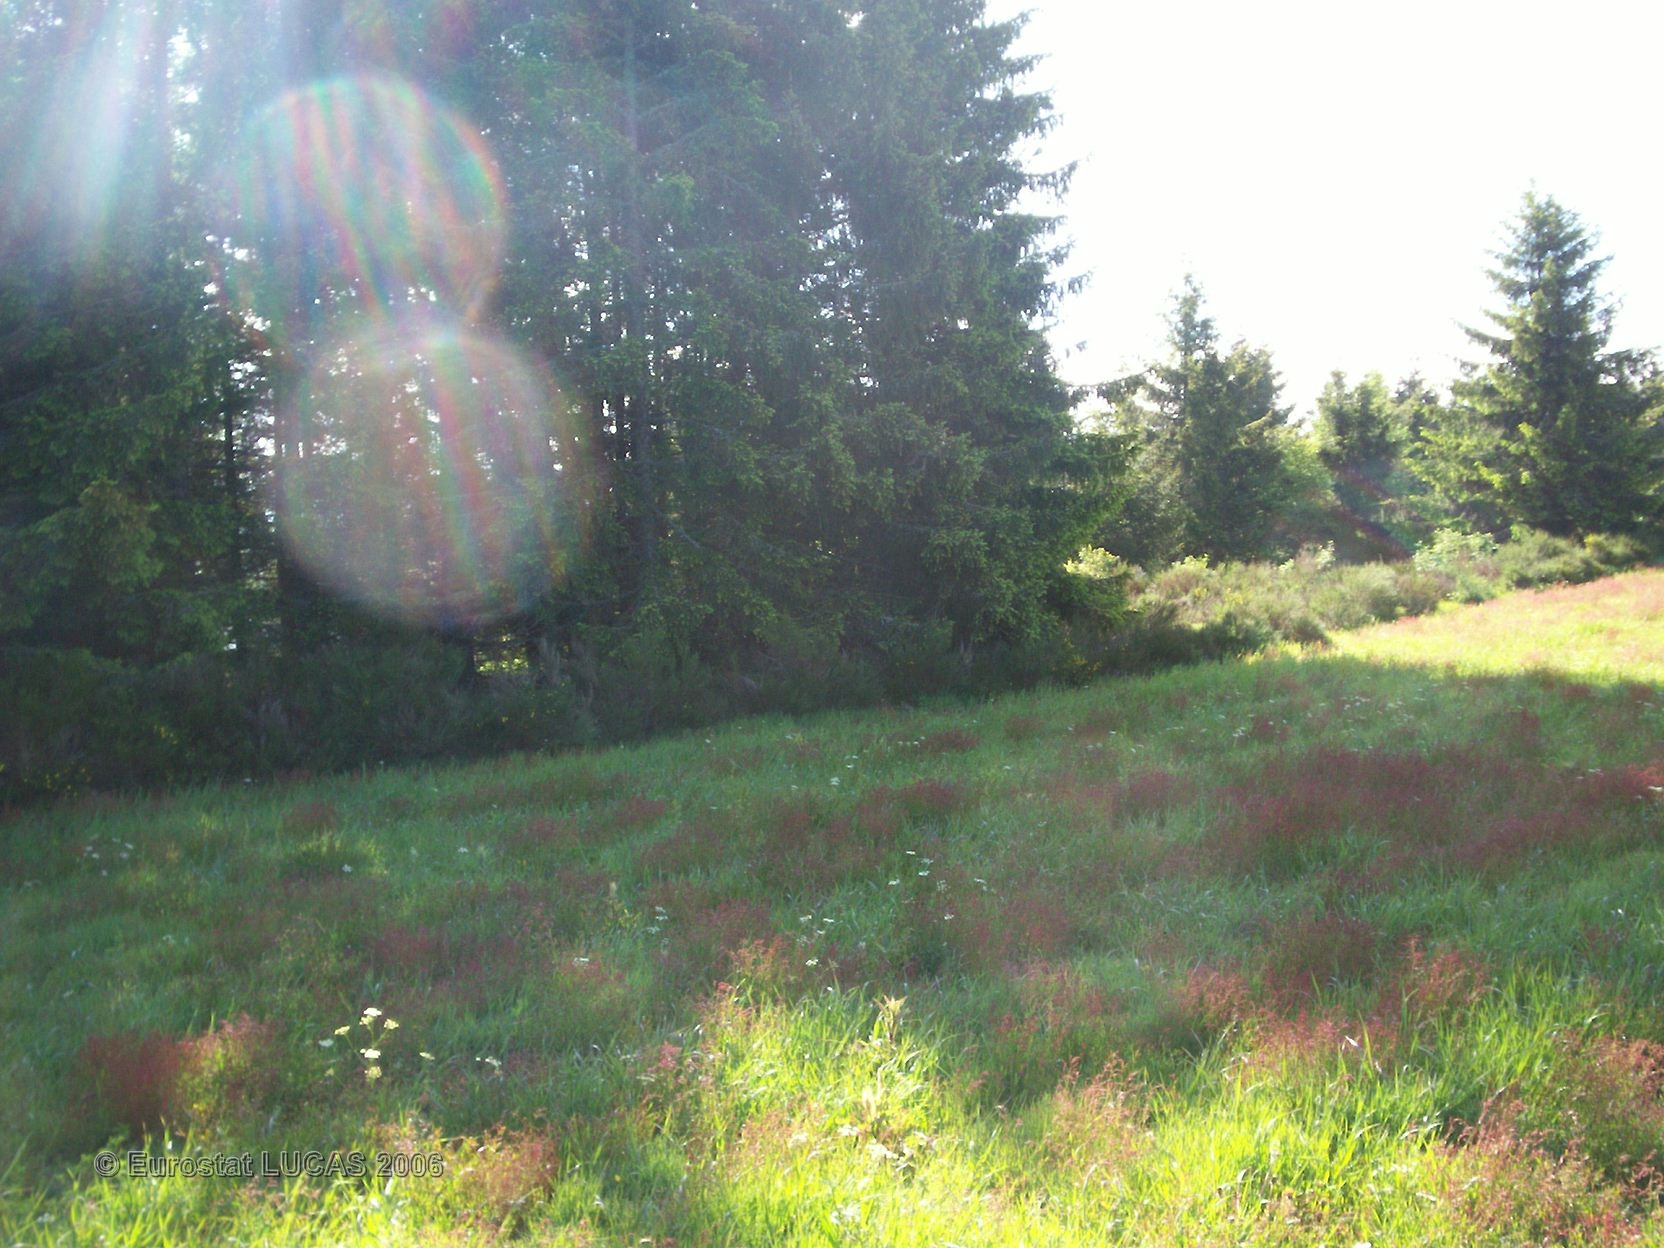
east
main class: Grassland
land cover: Grassland without tree/shrub cover
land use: Agriculture (excluding fallow land and kitchen gardens)
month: June
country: FR
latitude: 44.9526
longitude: 3.3741
